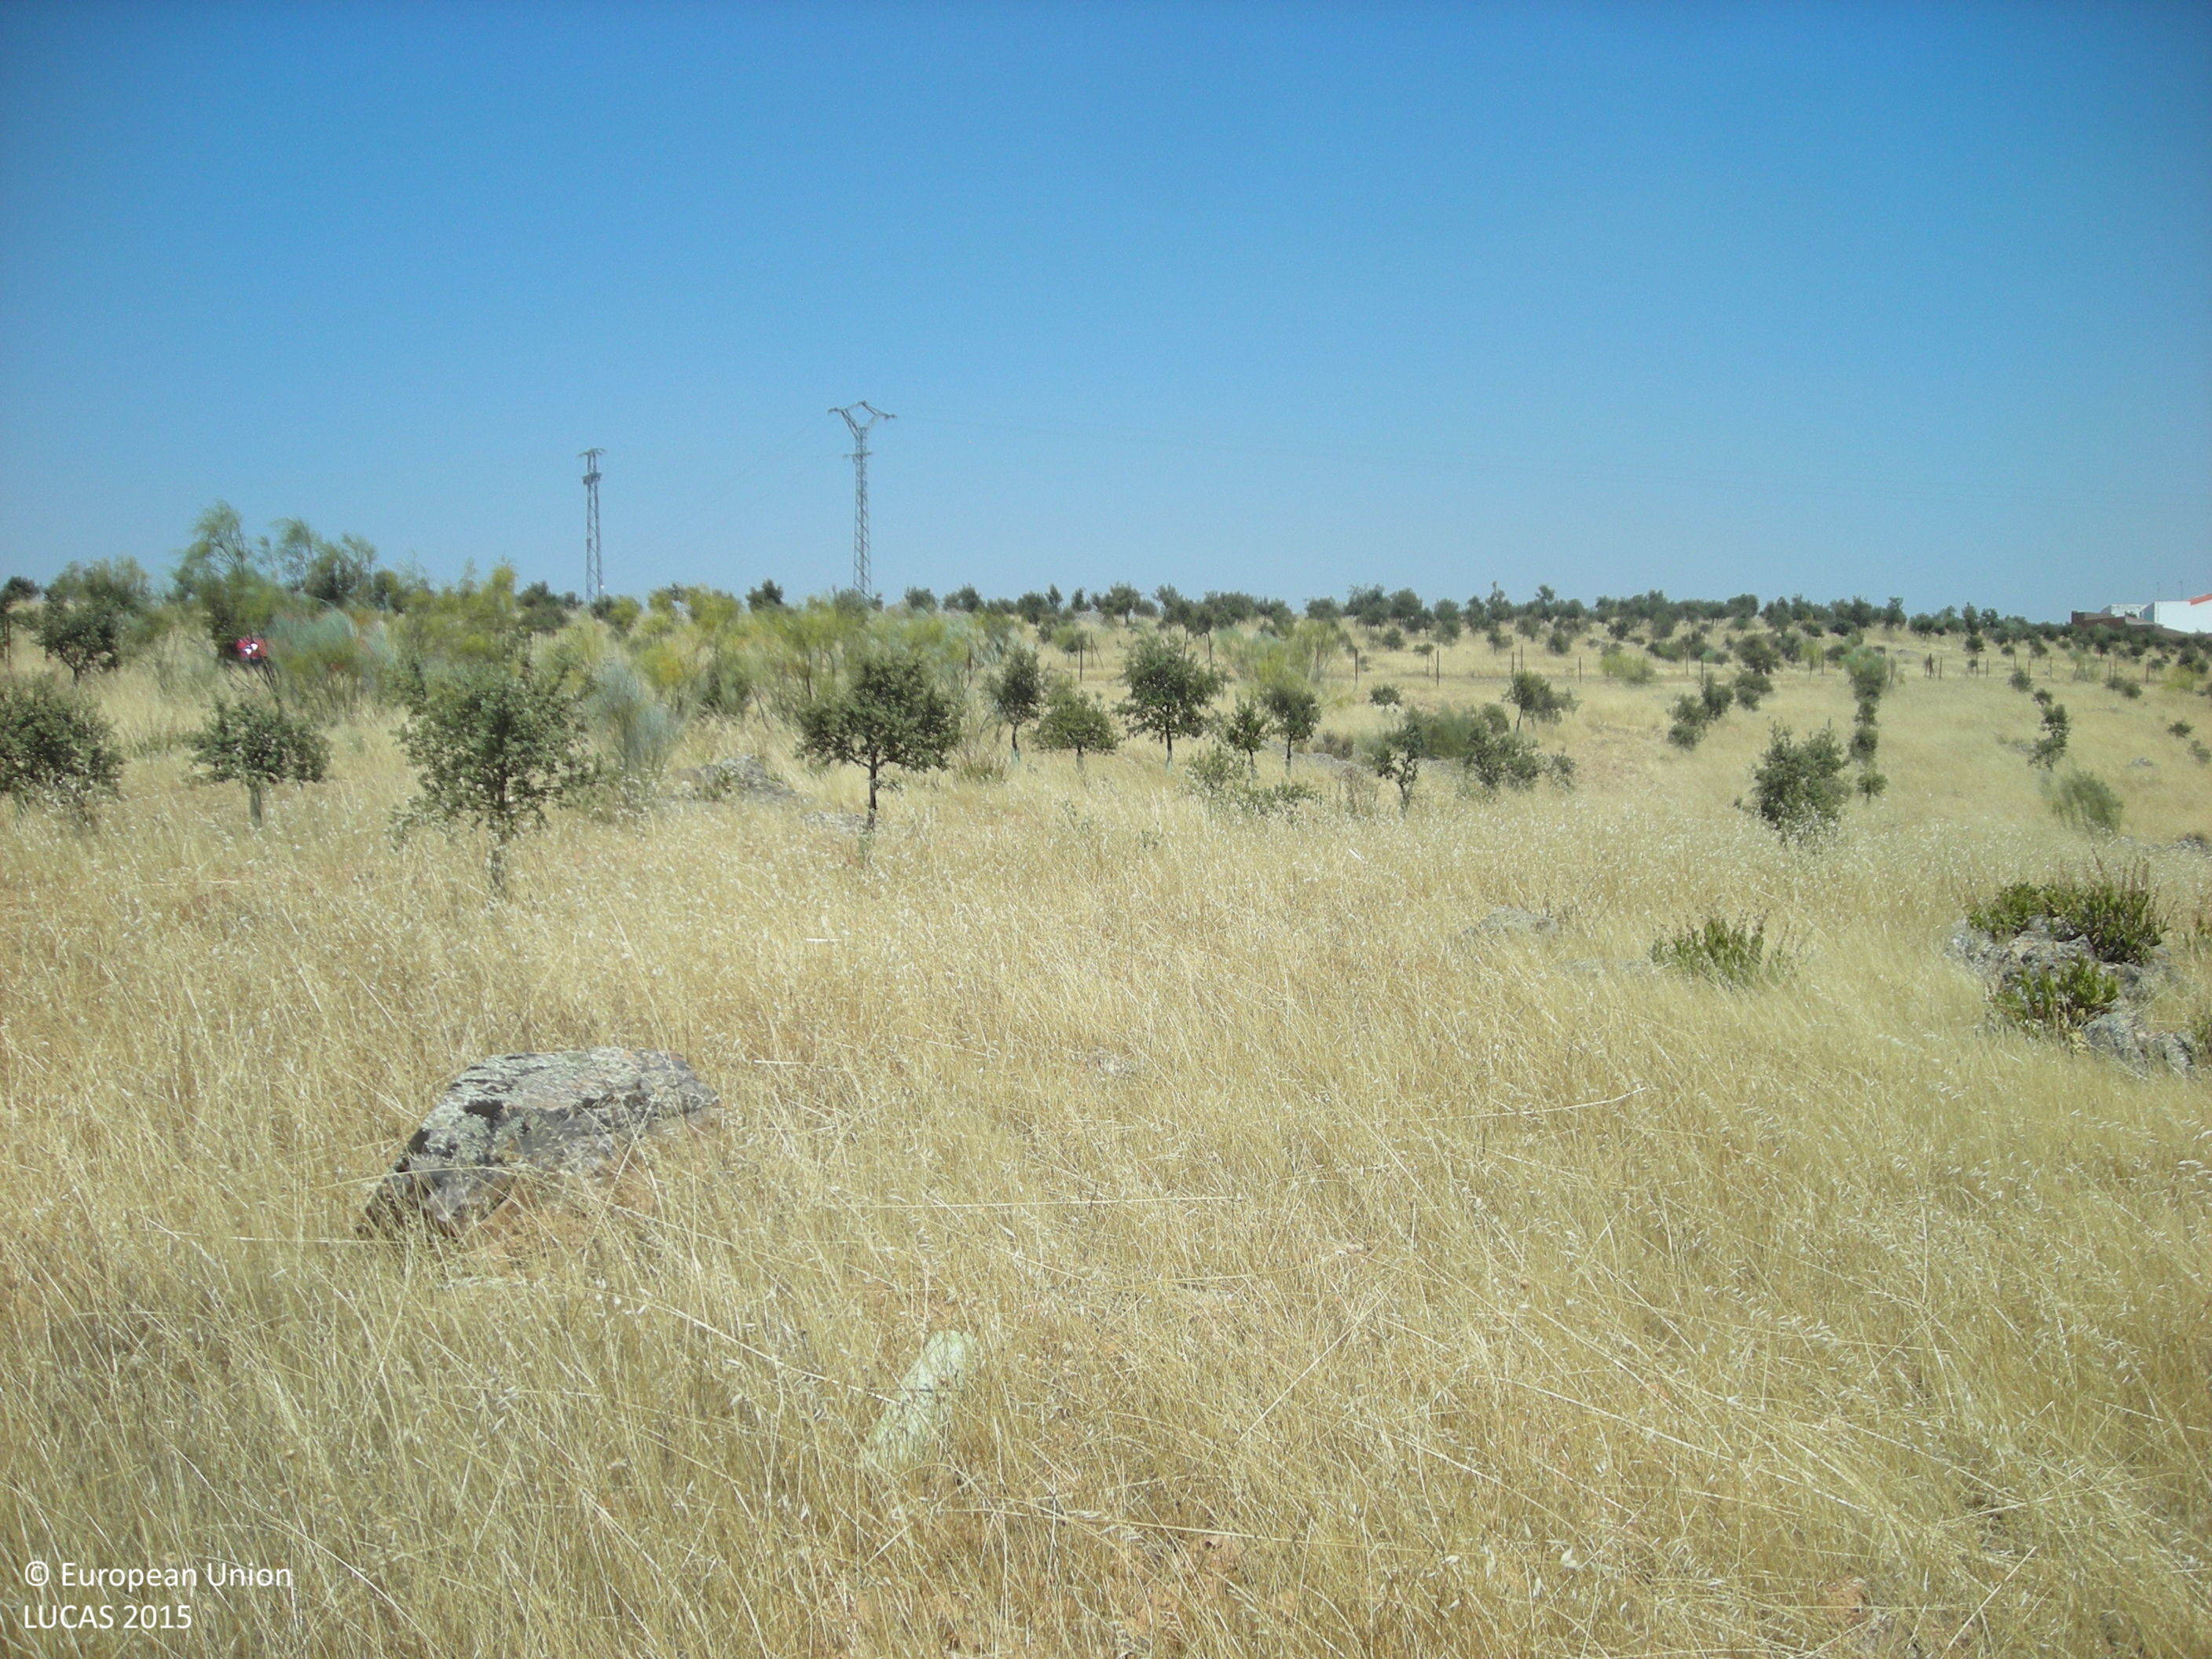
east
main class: Woodland
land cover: Broadleaved woodland
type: broadleaved evergreen forest
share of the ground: > 75 %
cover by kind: herbaceous plants 60 %, broadleaved forest trees 40 %
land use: Forestry
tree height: > 5 m
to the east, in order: Broadleaved woodland; Electric lines; Broadleaved woodland; Fences; Grass margins; Tracks; Grass margins; Fences; Broadleaved woodland
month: June
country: ES
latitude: 38.7005
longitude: -5.8083
